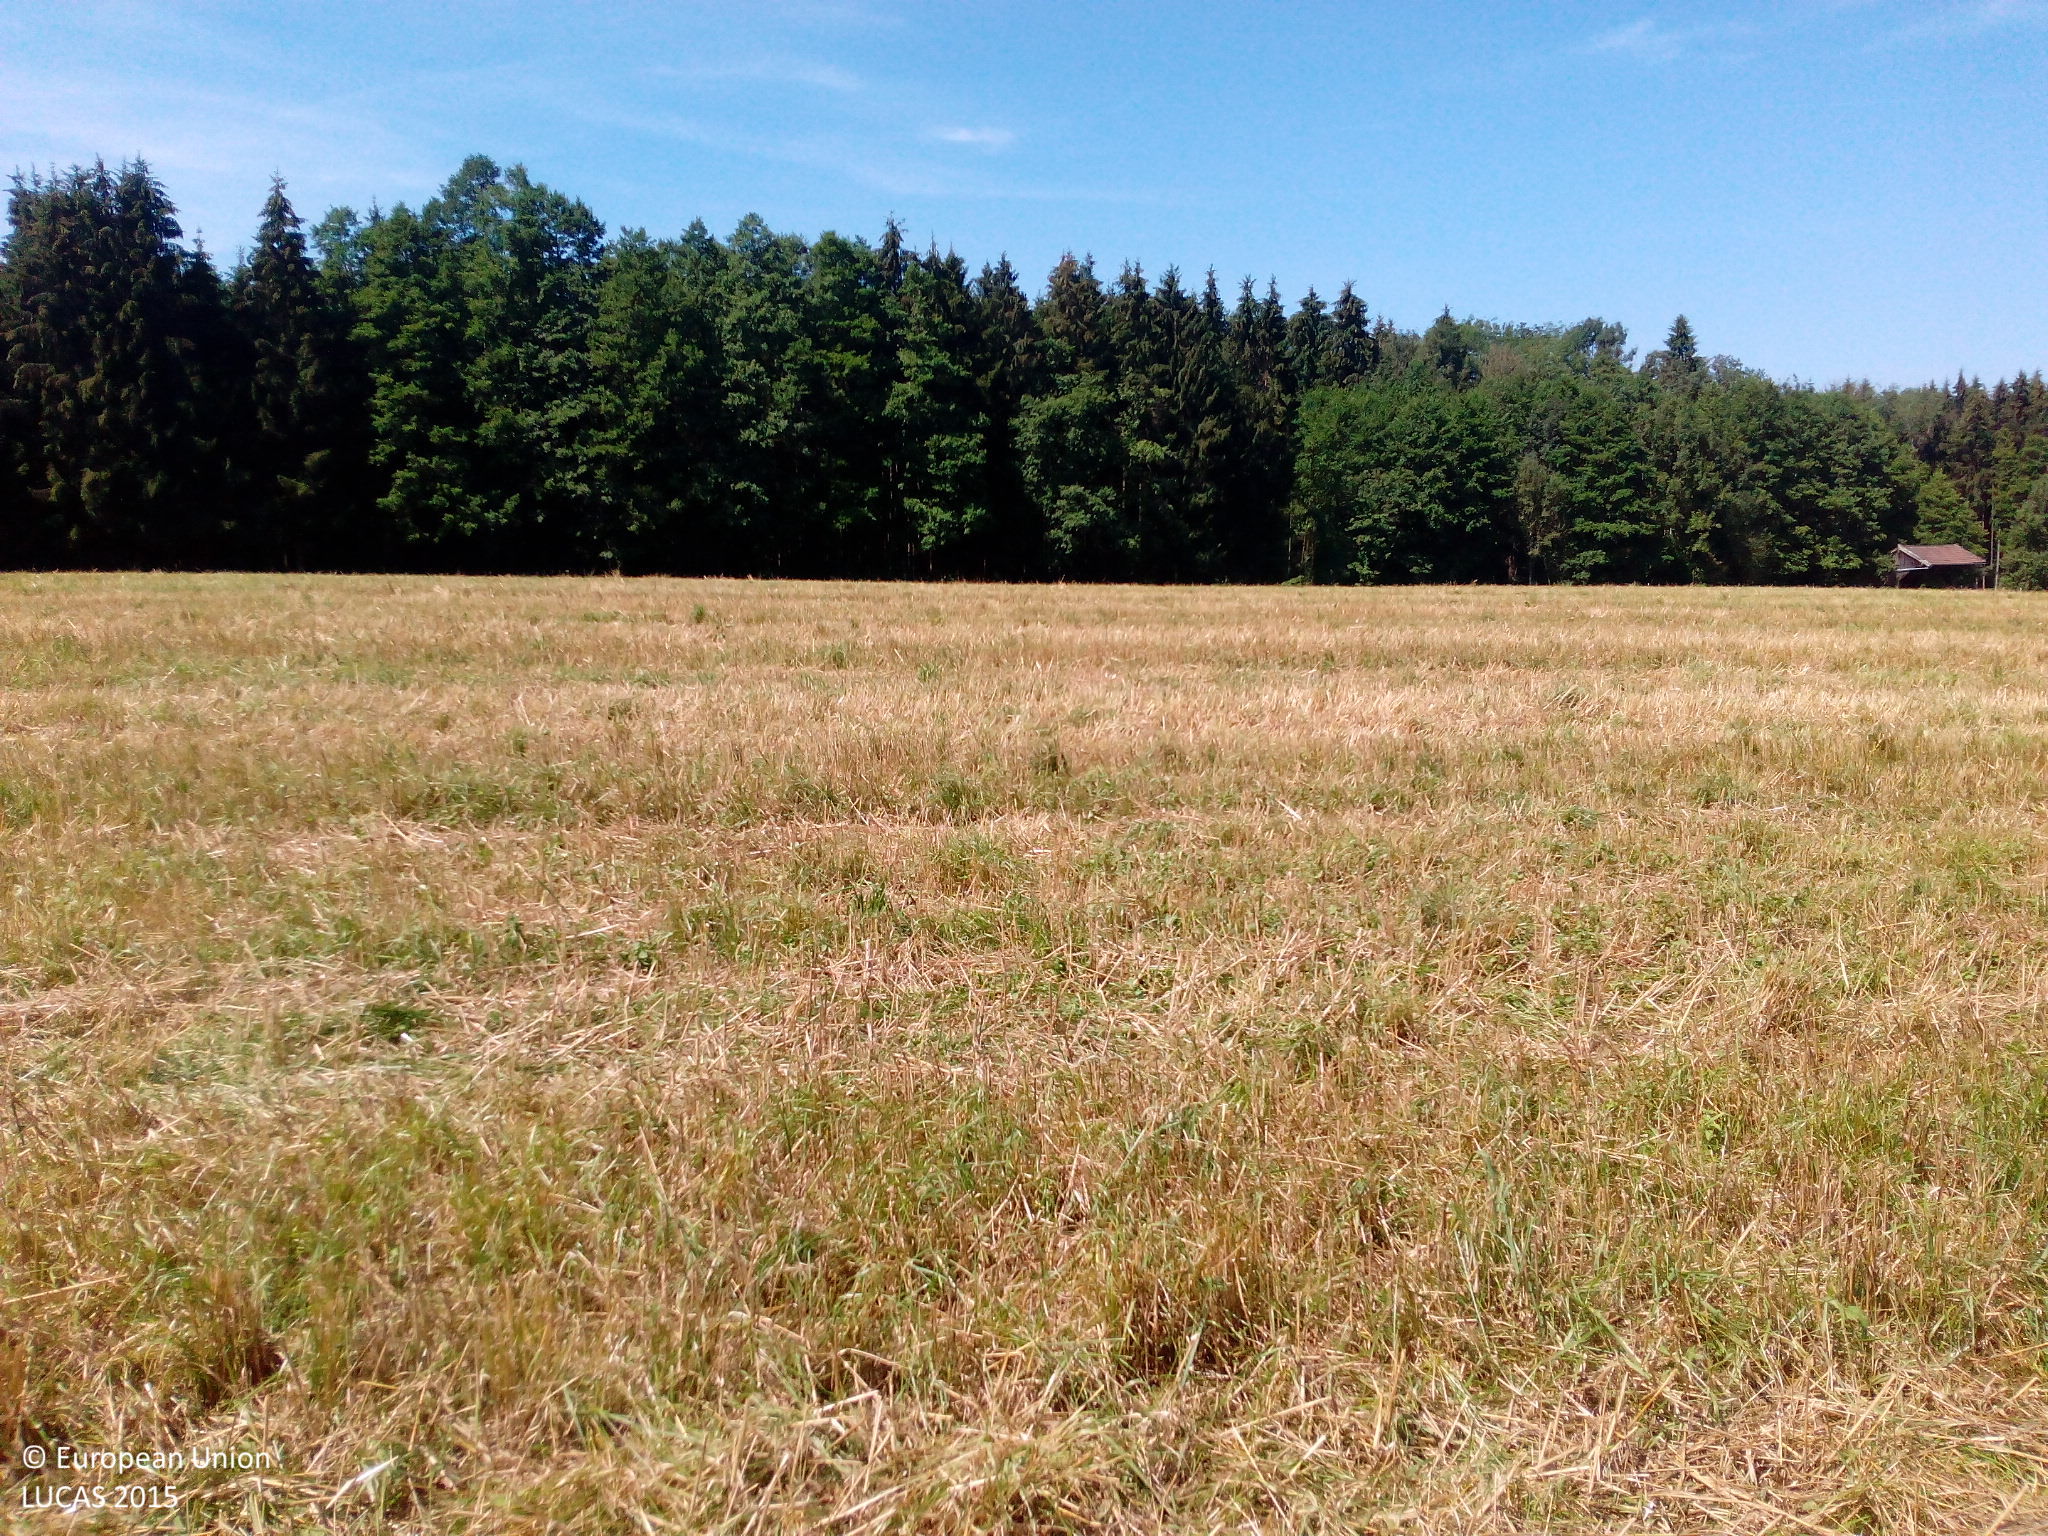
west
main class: Cropland
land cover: Common wheat
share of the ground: > 75 %
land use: Agriculture (excluding fallow land and kitchen gardens)
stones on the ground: < 10 %
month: August
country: DE
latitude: 47.9519
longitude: 12.8776
